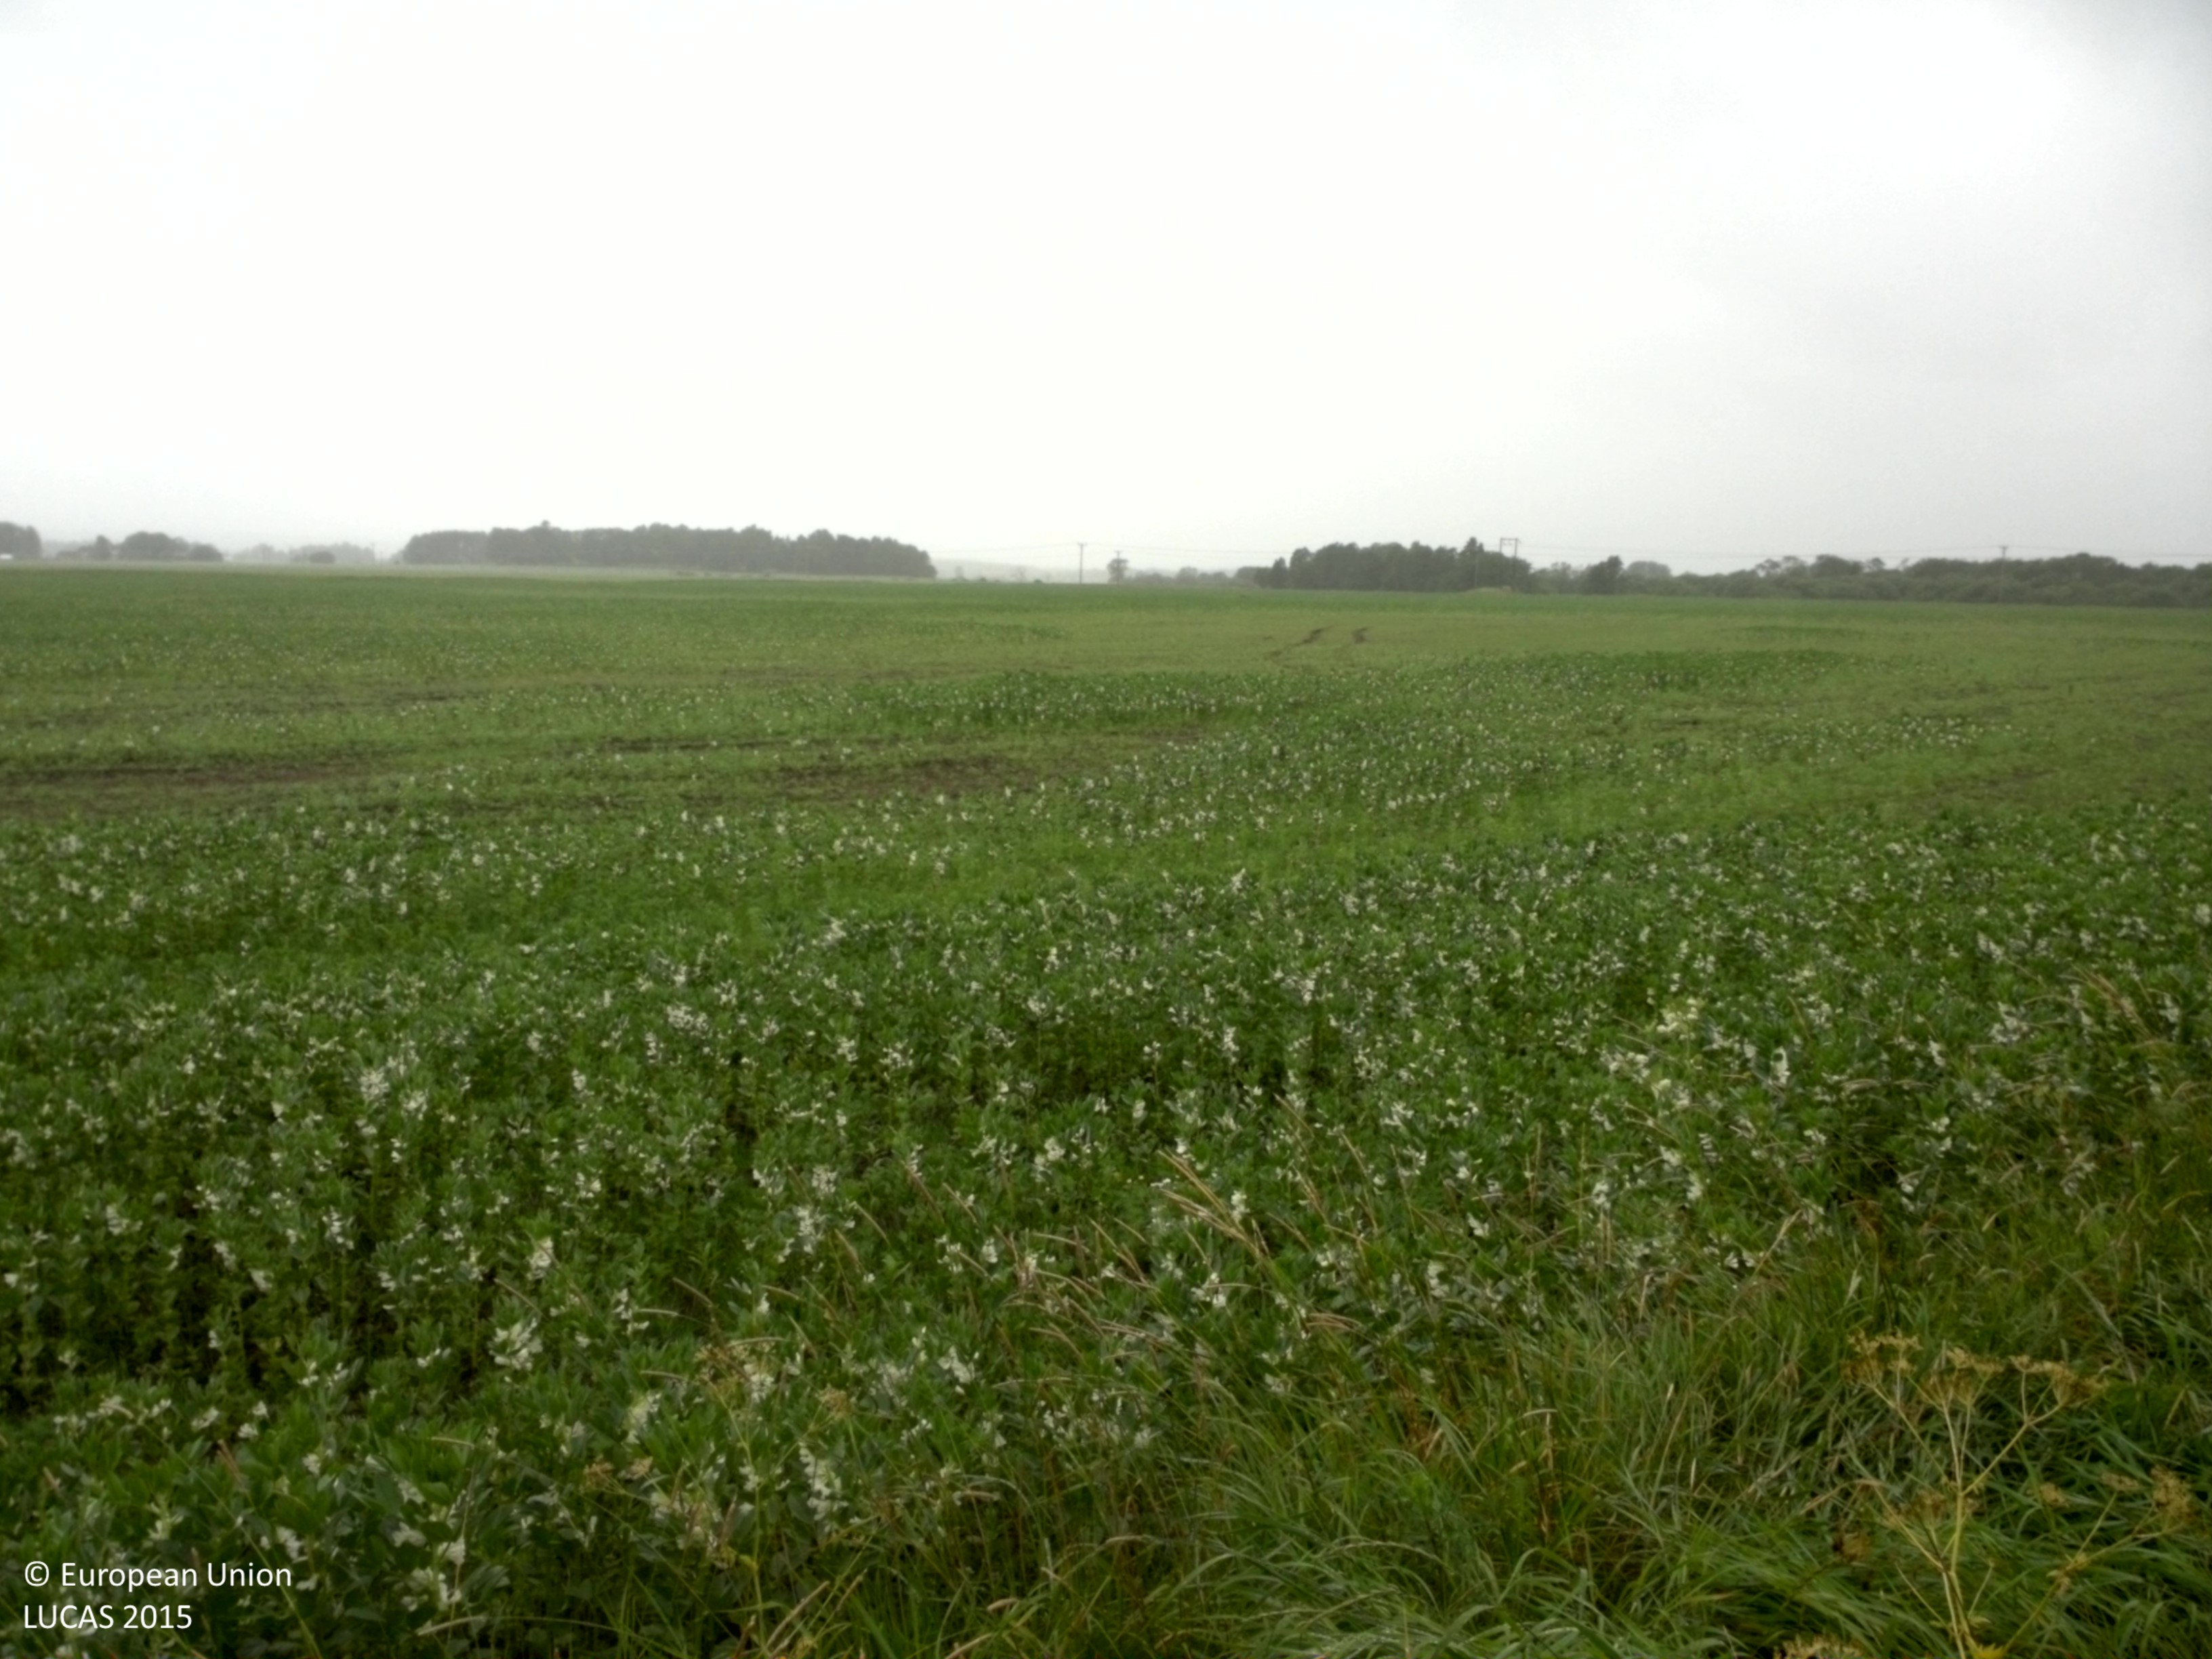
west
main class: Cropland
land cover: Dry pulses
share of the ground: > 75 %
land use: Agriculture (excluding fallow land and kitchen gardens)
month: July
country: SE
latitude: 58.5404
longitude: 13.9275
